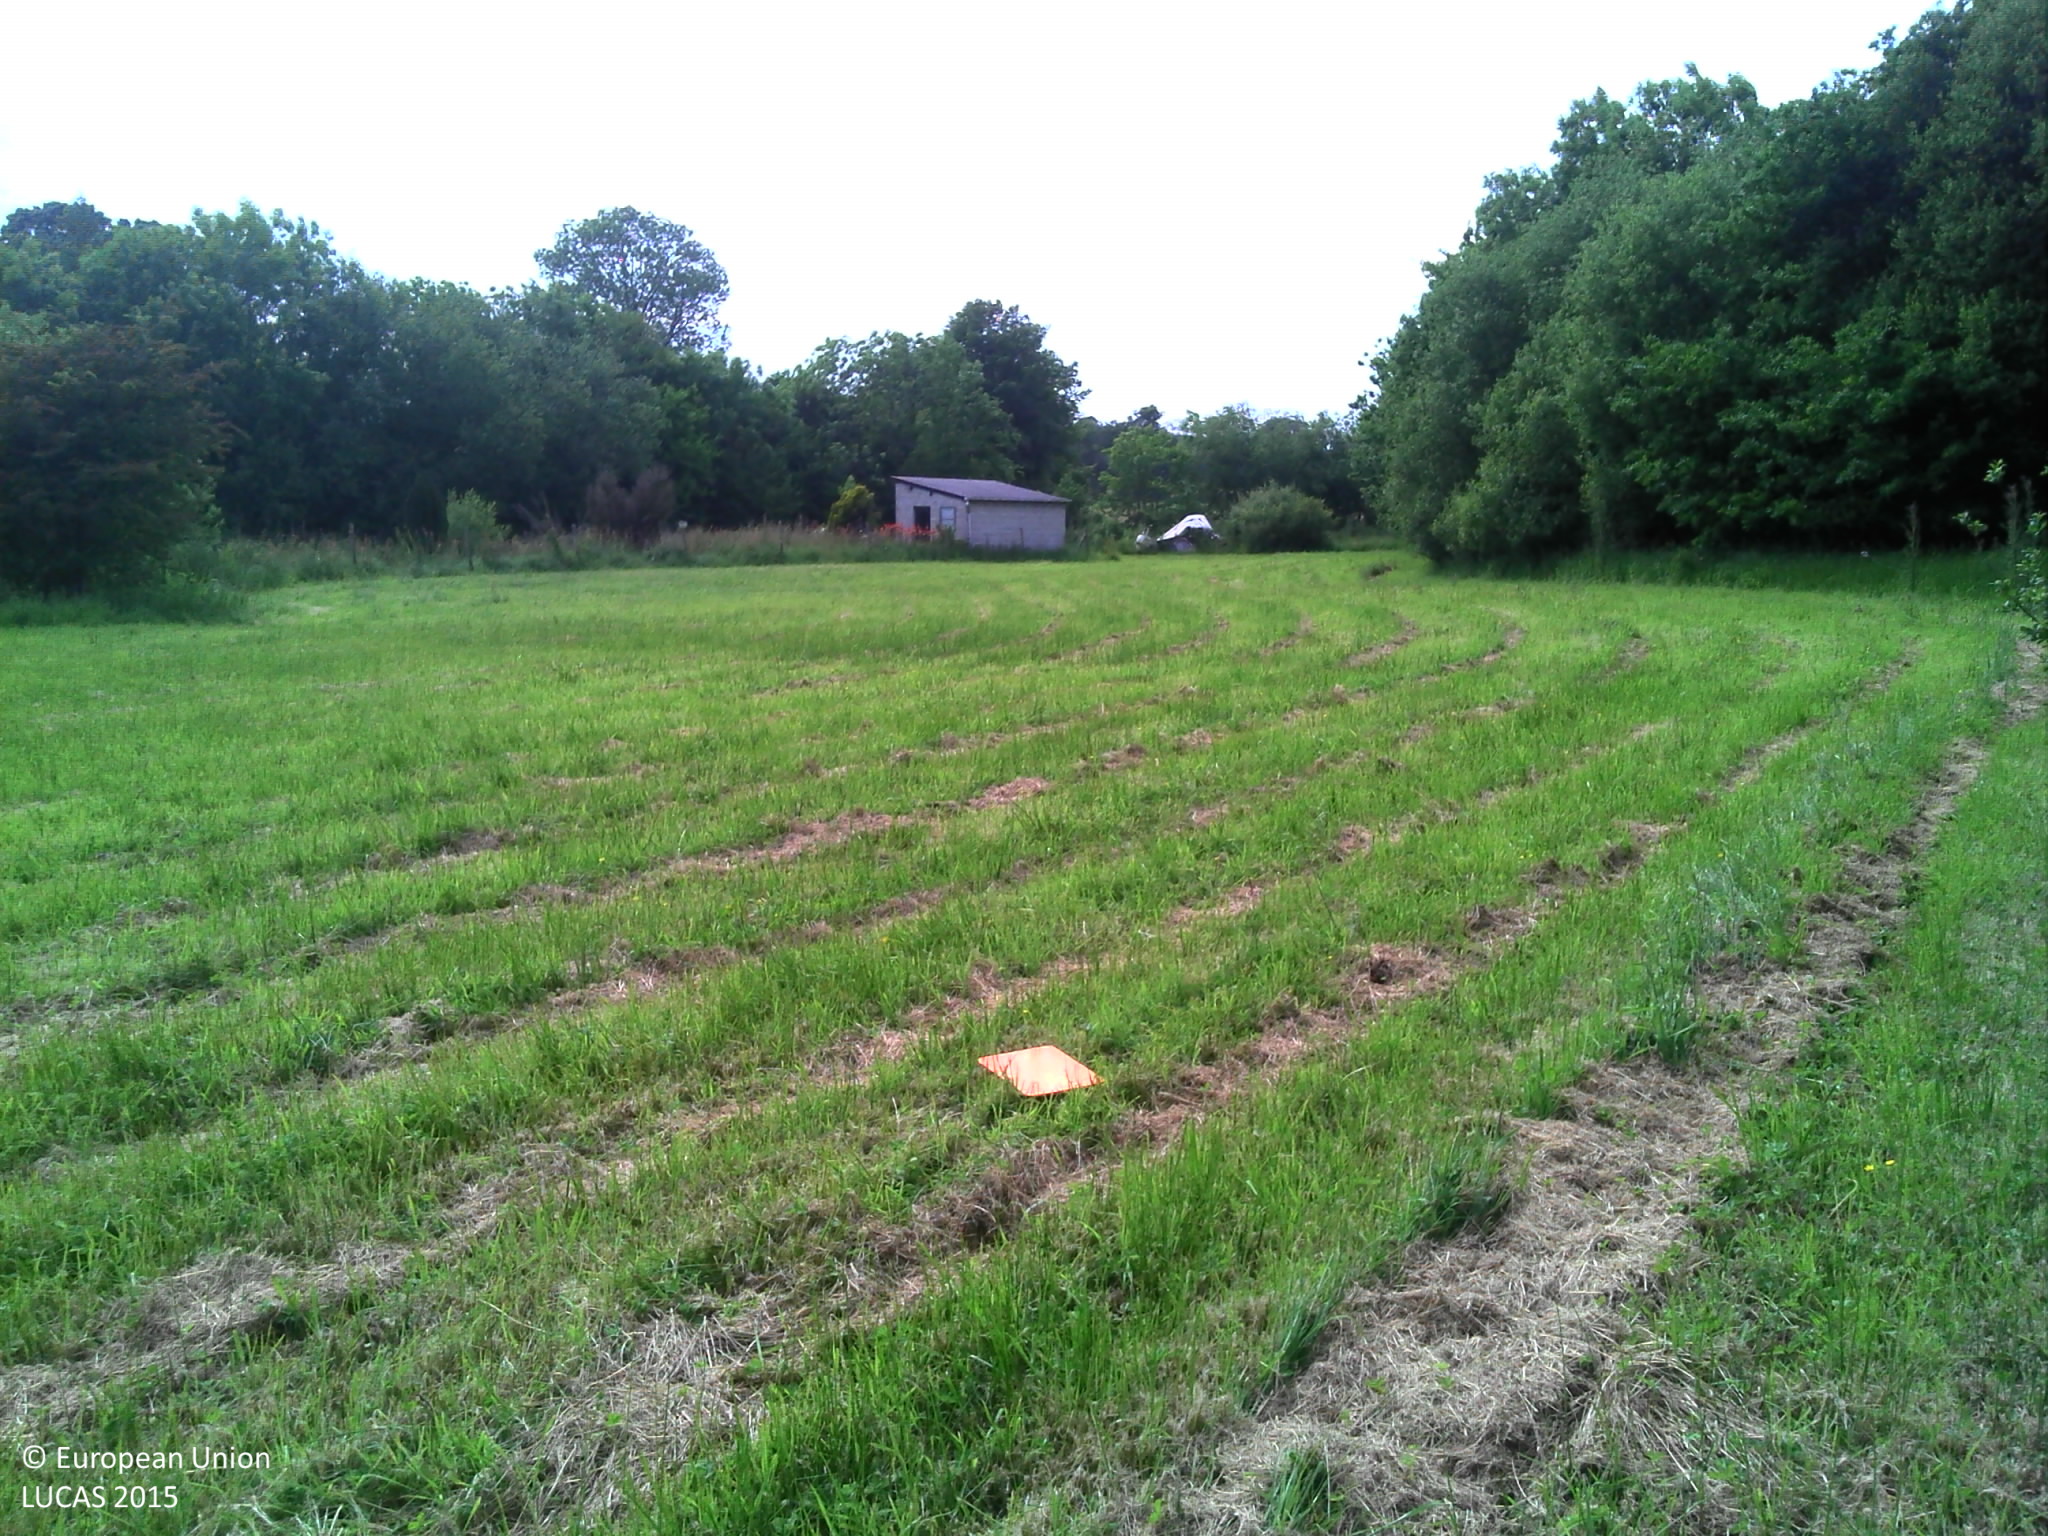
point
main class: Grassland
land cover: Grassland without tree/shrub cover
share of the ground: > 75 %
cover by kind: herbaceous plants 100 %
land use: Agriculture (excluding fallow land and kitchen gardens)
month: June
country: FR
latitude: 49.5001
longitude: -1.4122
